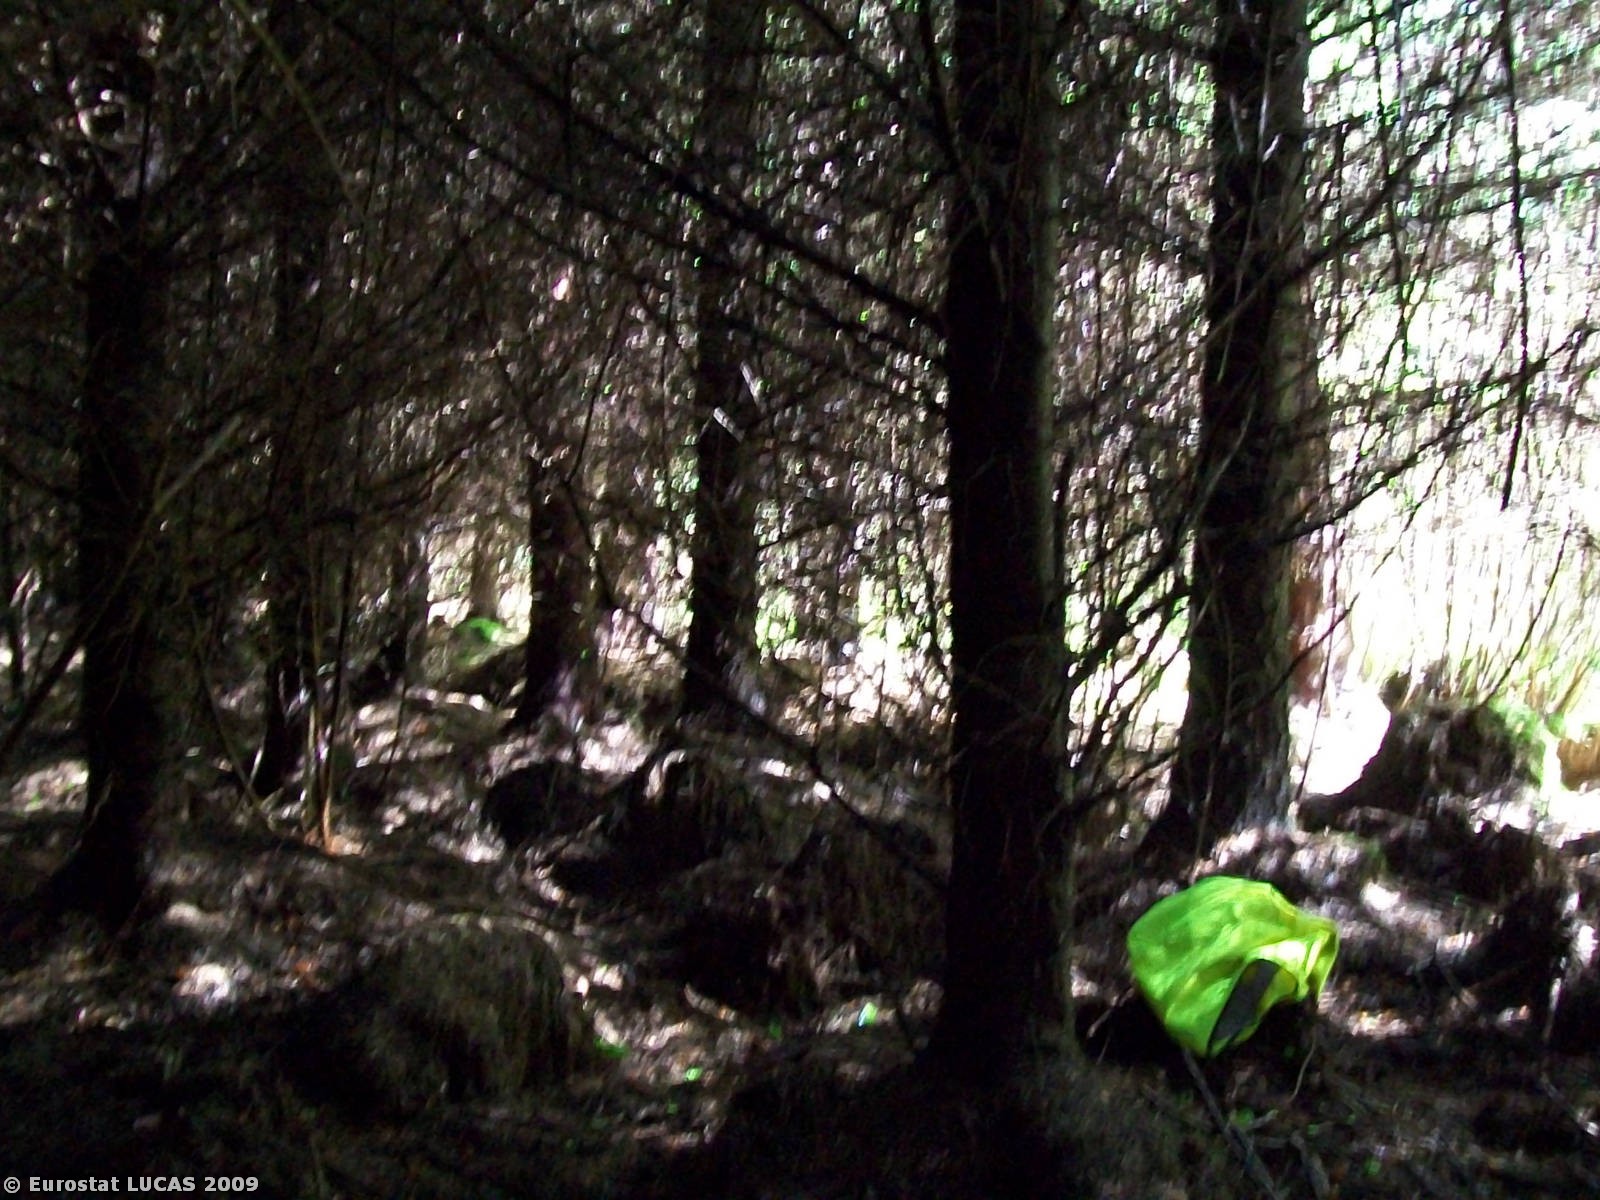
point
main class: Woodland
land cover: Coniferous woodland
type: plantations and self-sown exotic forest
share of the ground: > 75 %
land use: Forestry
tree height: > 5 m
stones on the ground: < 10 %
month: May
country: IE
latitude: 51.8356
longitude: -8.7957
